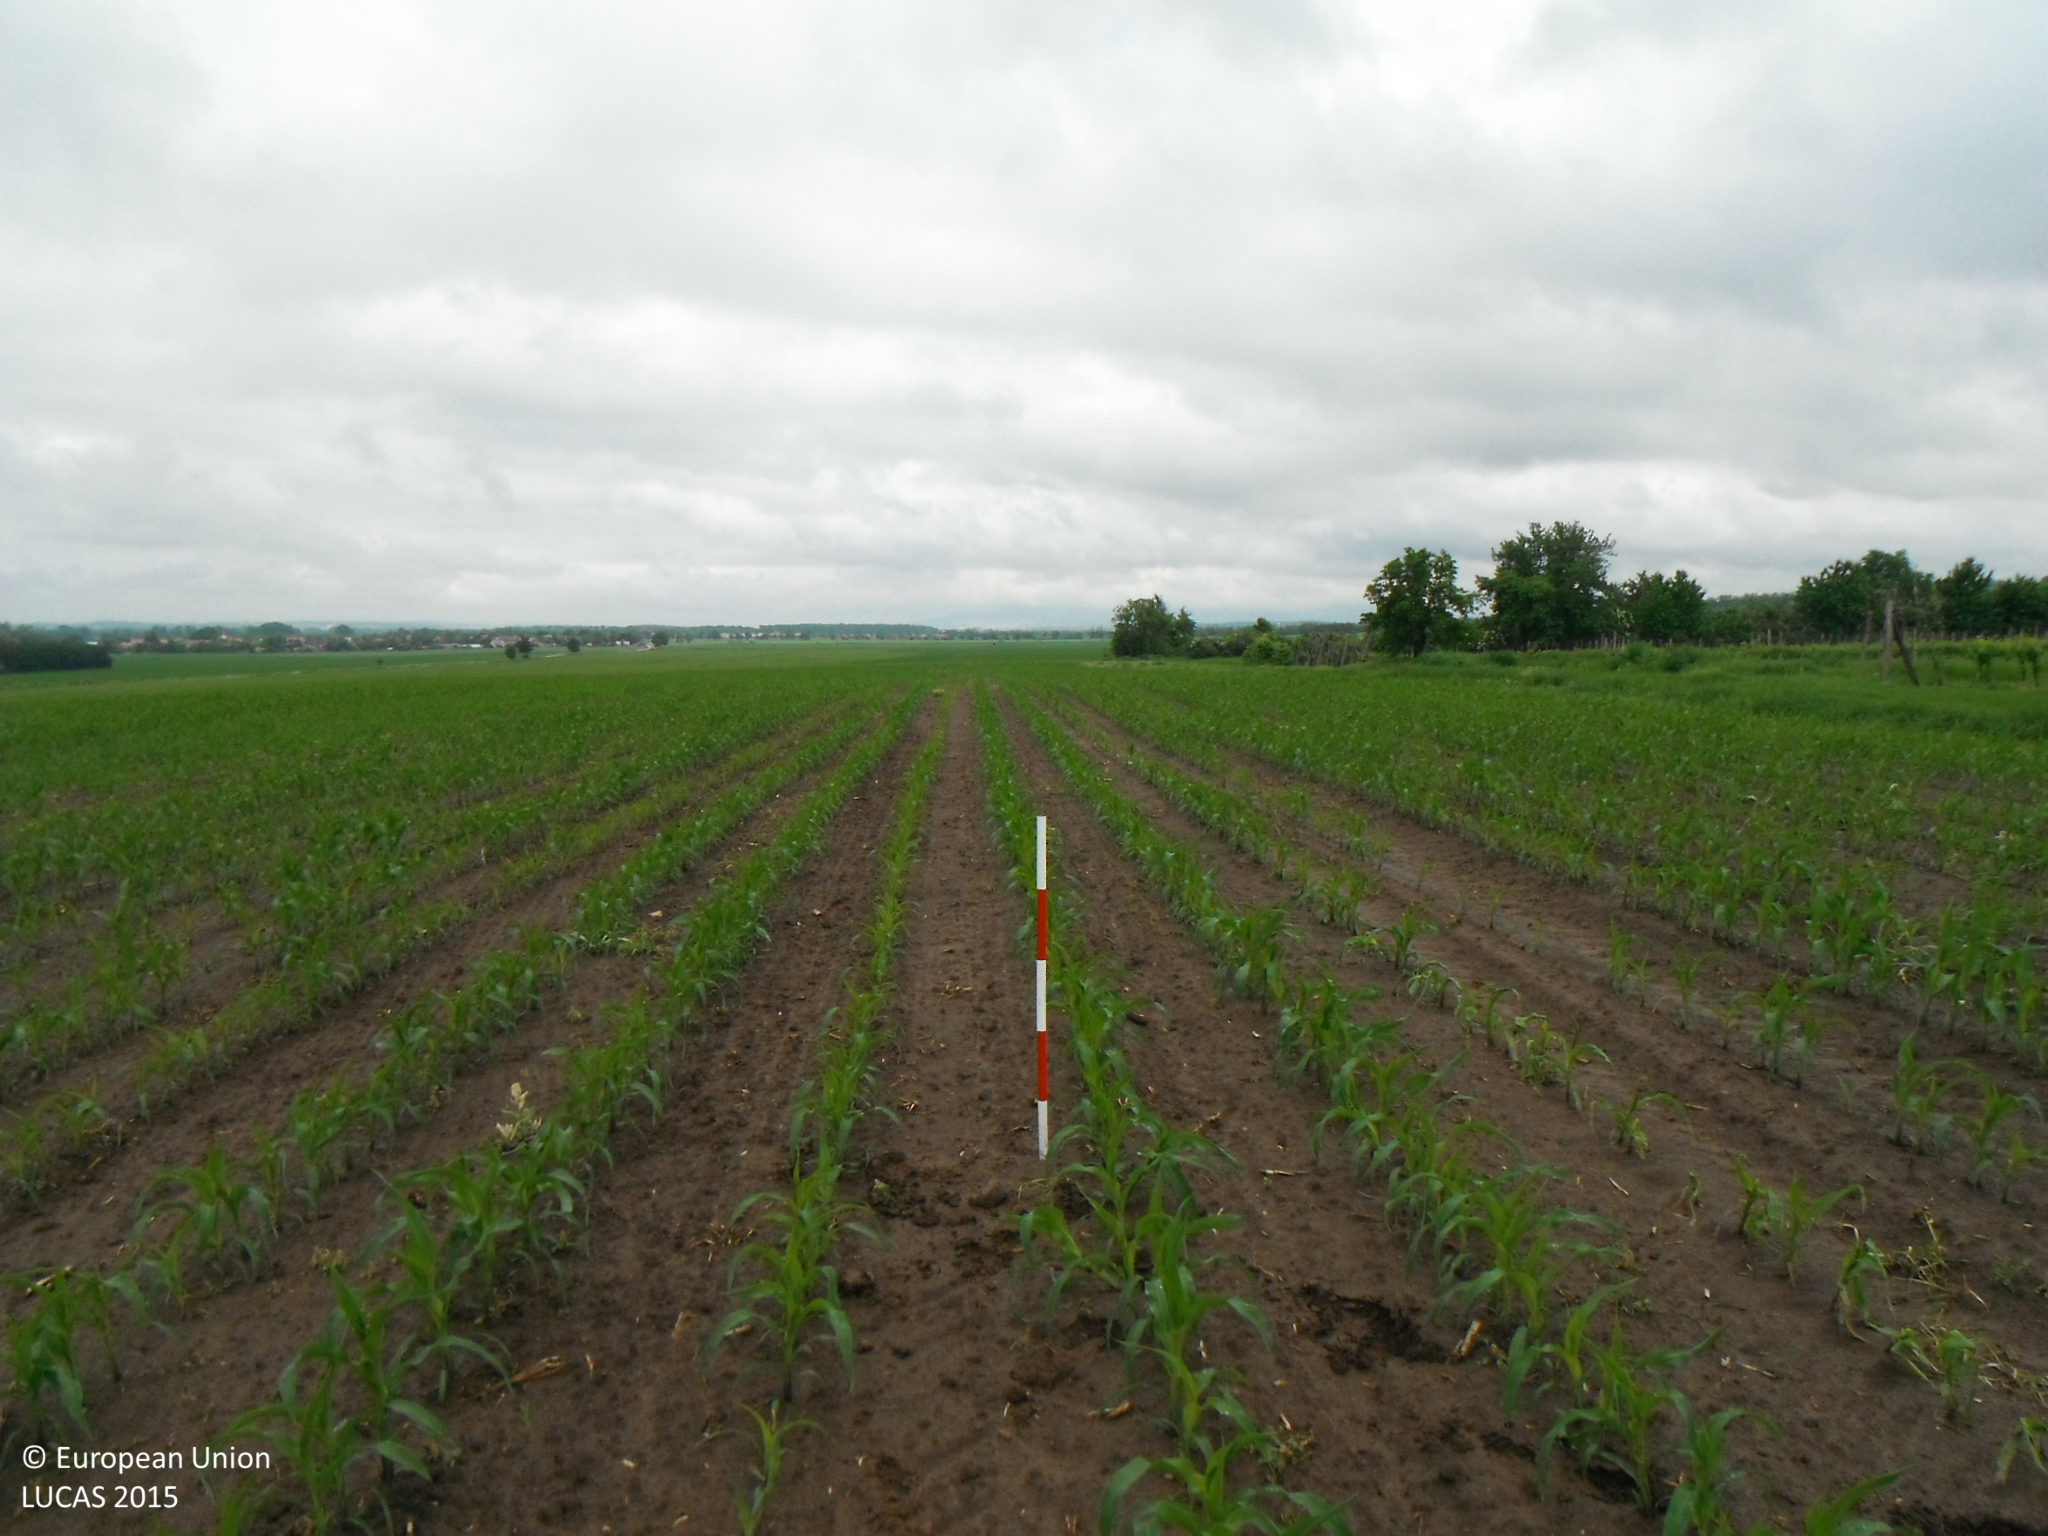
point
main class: Cropland
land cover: Maize
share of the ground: 25 - 50 %
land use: Agriculture (excluding fallow land and kitchen gardens)
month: May
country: SK
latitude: 48.1687
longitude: 18.2299
